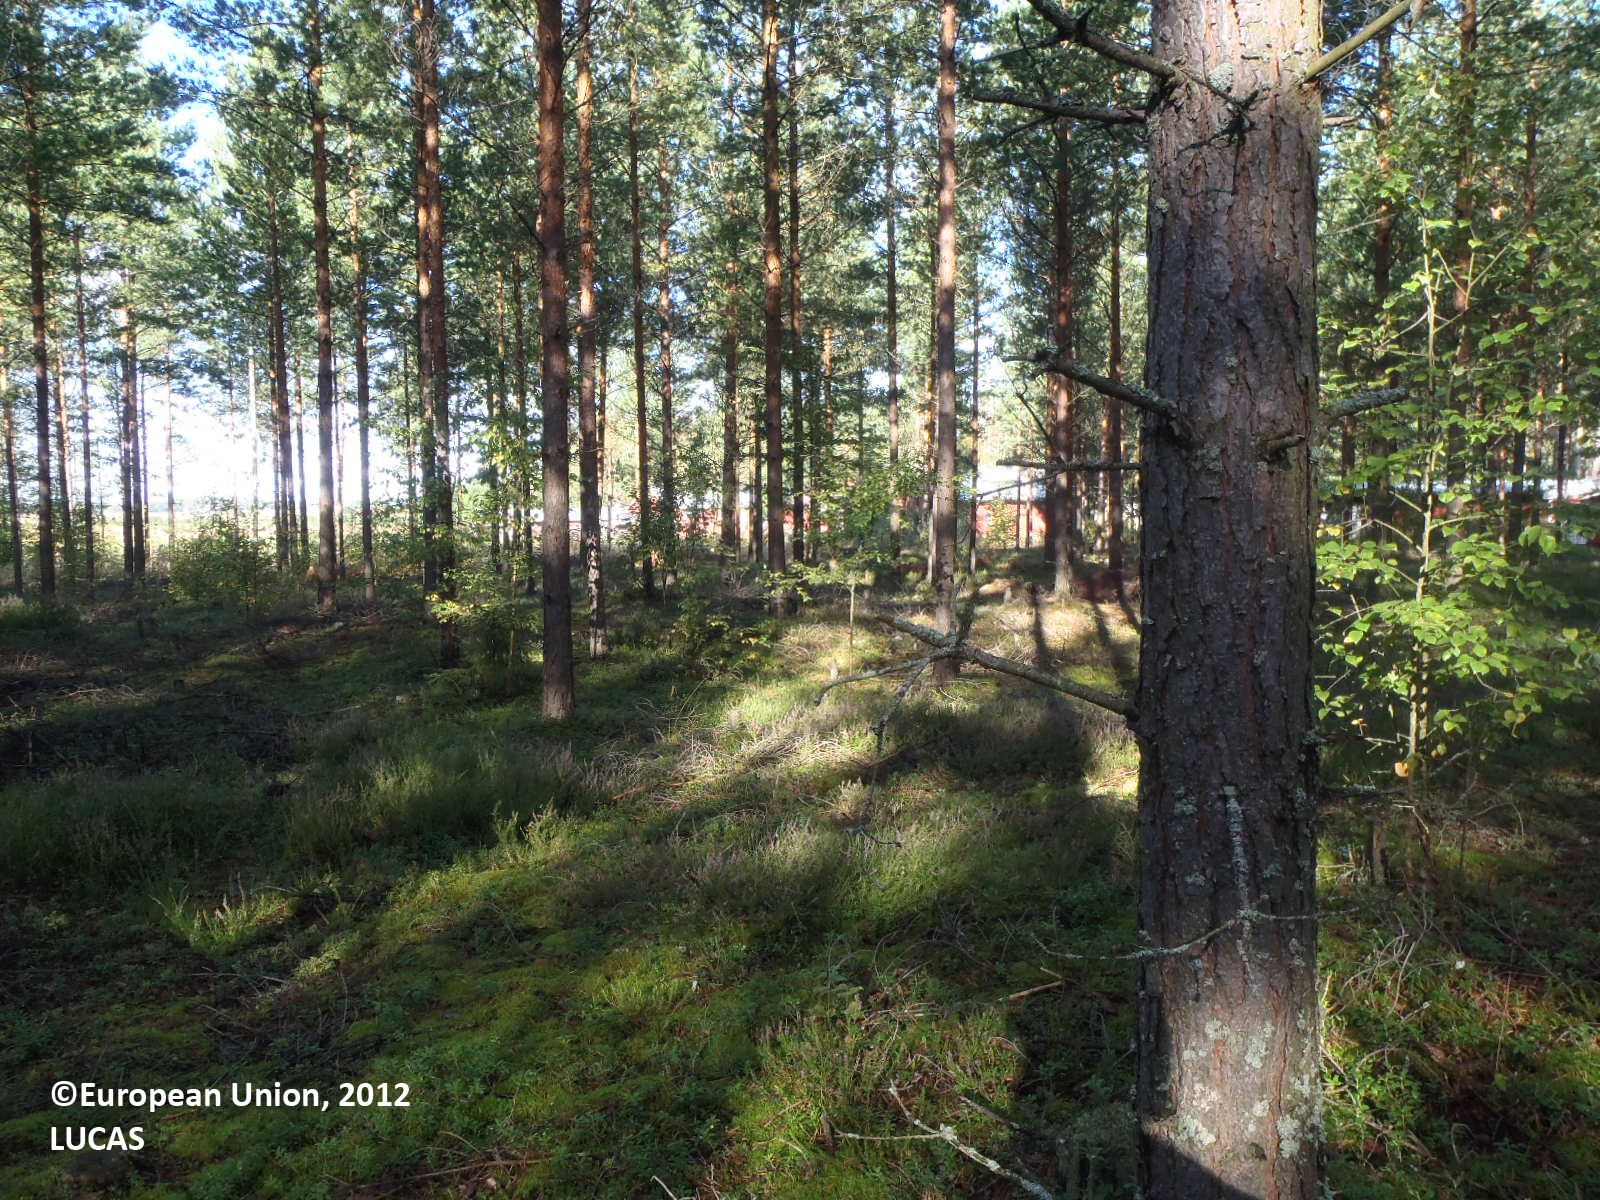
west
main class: Woodland
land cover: Pine dominated coniferous woodland
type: boreal forest
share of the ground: > 75 %
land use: Forestry
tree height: > 5 m
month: September
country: FI
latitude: 61.0746
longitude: 22.3901
